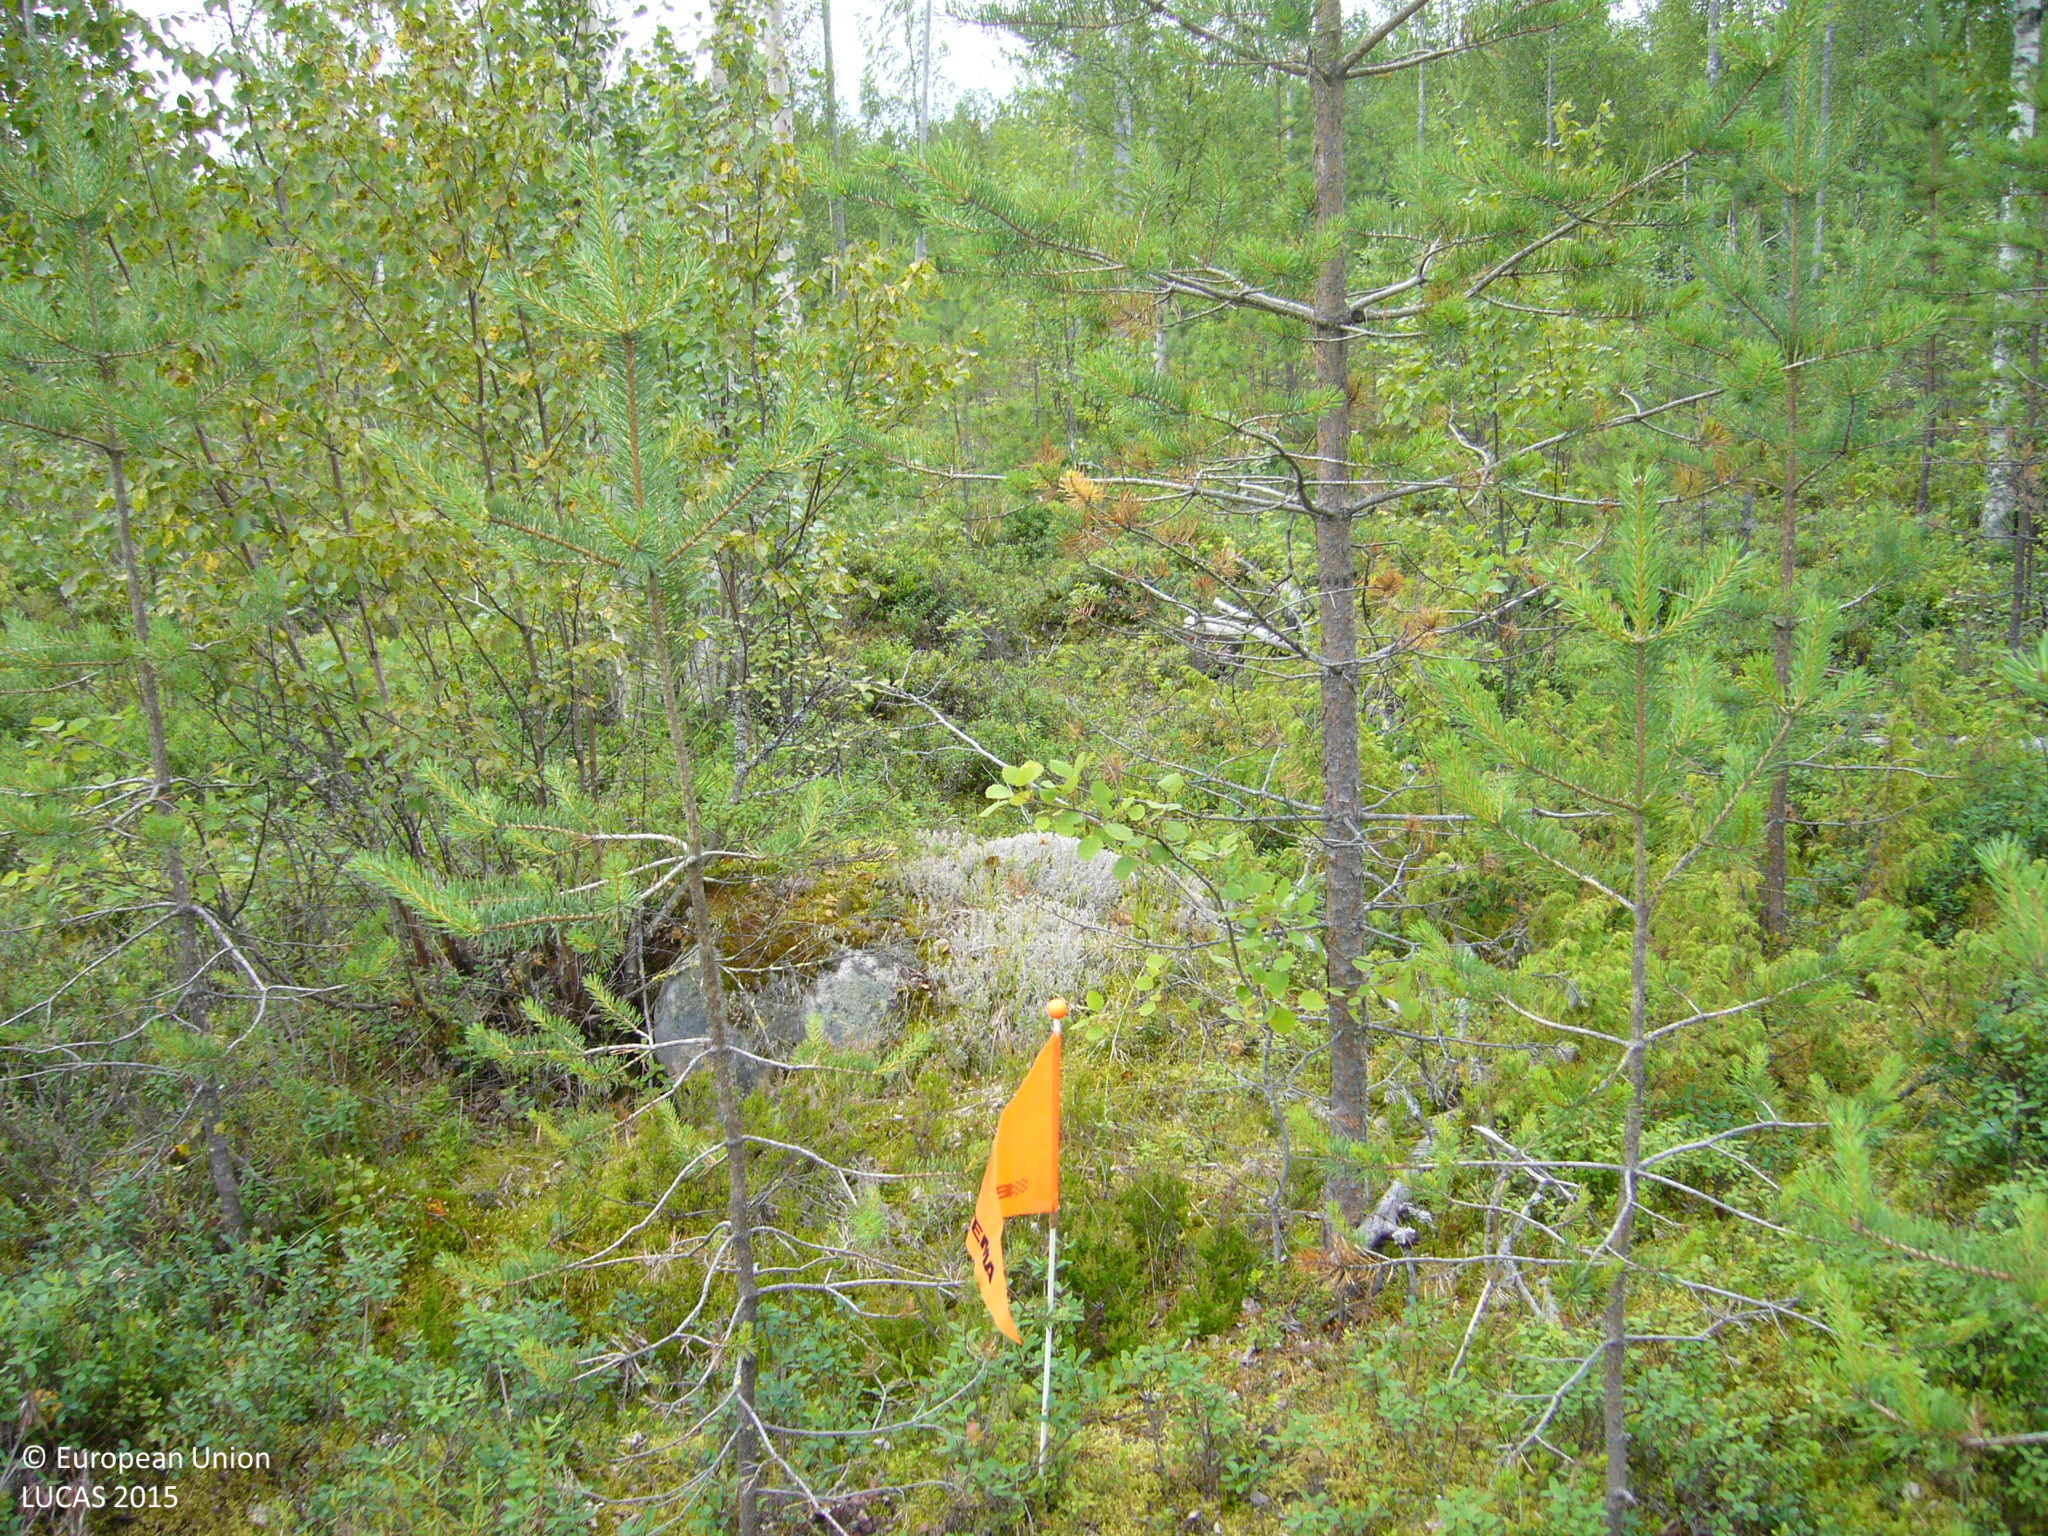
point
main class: Woodland
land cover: Pine dominated mixed woodland
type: boreal forest
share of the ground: 50 - 75 %
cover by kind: coniferous forest trees 40 %, broadleaved forest trees 30 %, shrubs 30 %
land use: Forestry
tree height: < 5 m
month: July
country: FI
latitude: 63.9755
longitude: 26.2736
